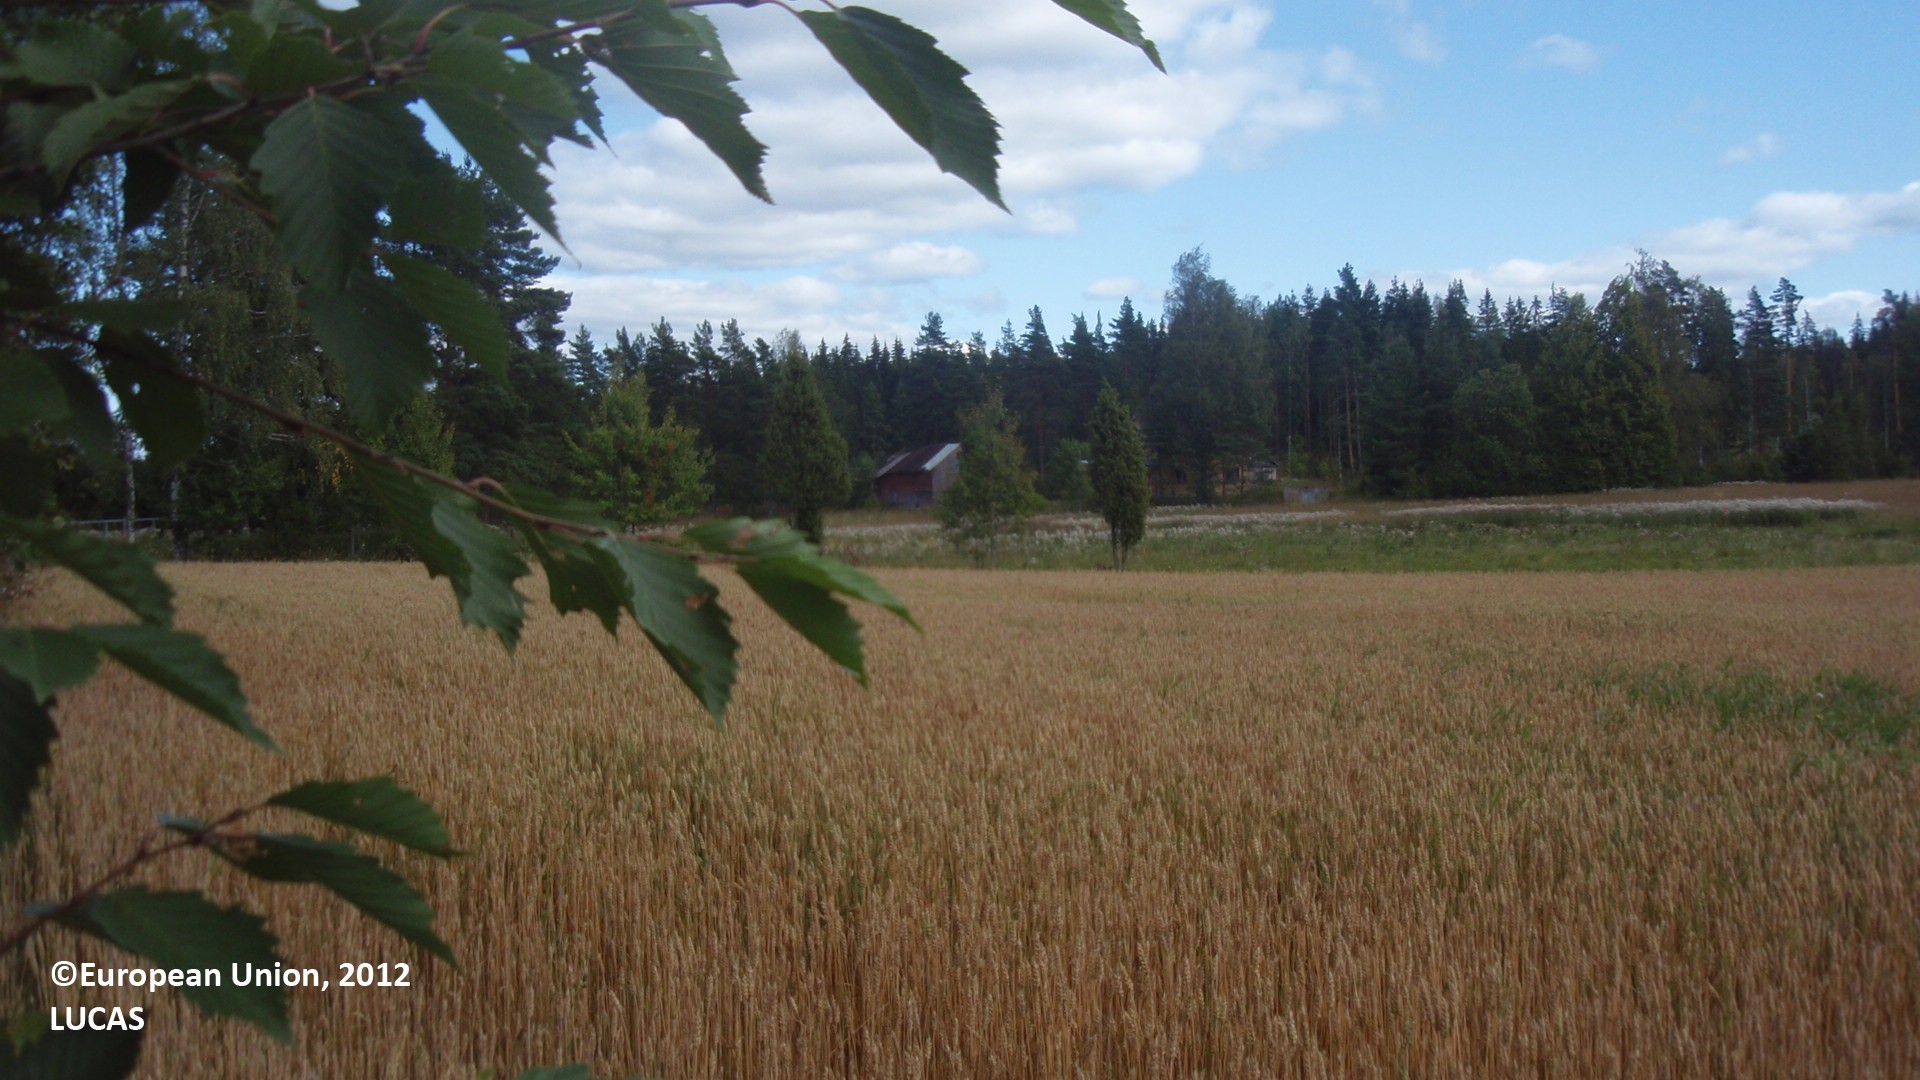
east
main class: Cropland
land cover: Common wheat
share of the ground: > 75 %
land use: Agriculture (excluding fallow land and kitchen gardens)
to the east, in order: Common wheat; Grass margins; Ditches and canals; Temporary grasslands; Common wheat; Pine dominated mixed woodland; Artificial constructions in urban areas; Tracks; Spruce dominated coniferous woodland
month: August
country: FI
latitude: 60.6854
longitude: 27.4877
